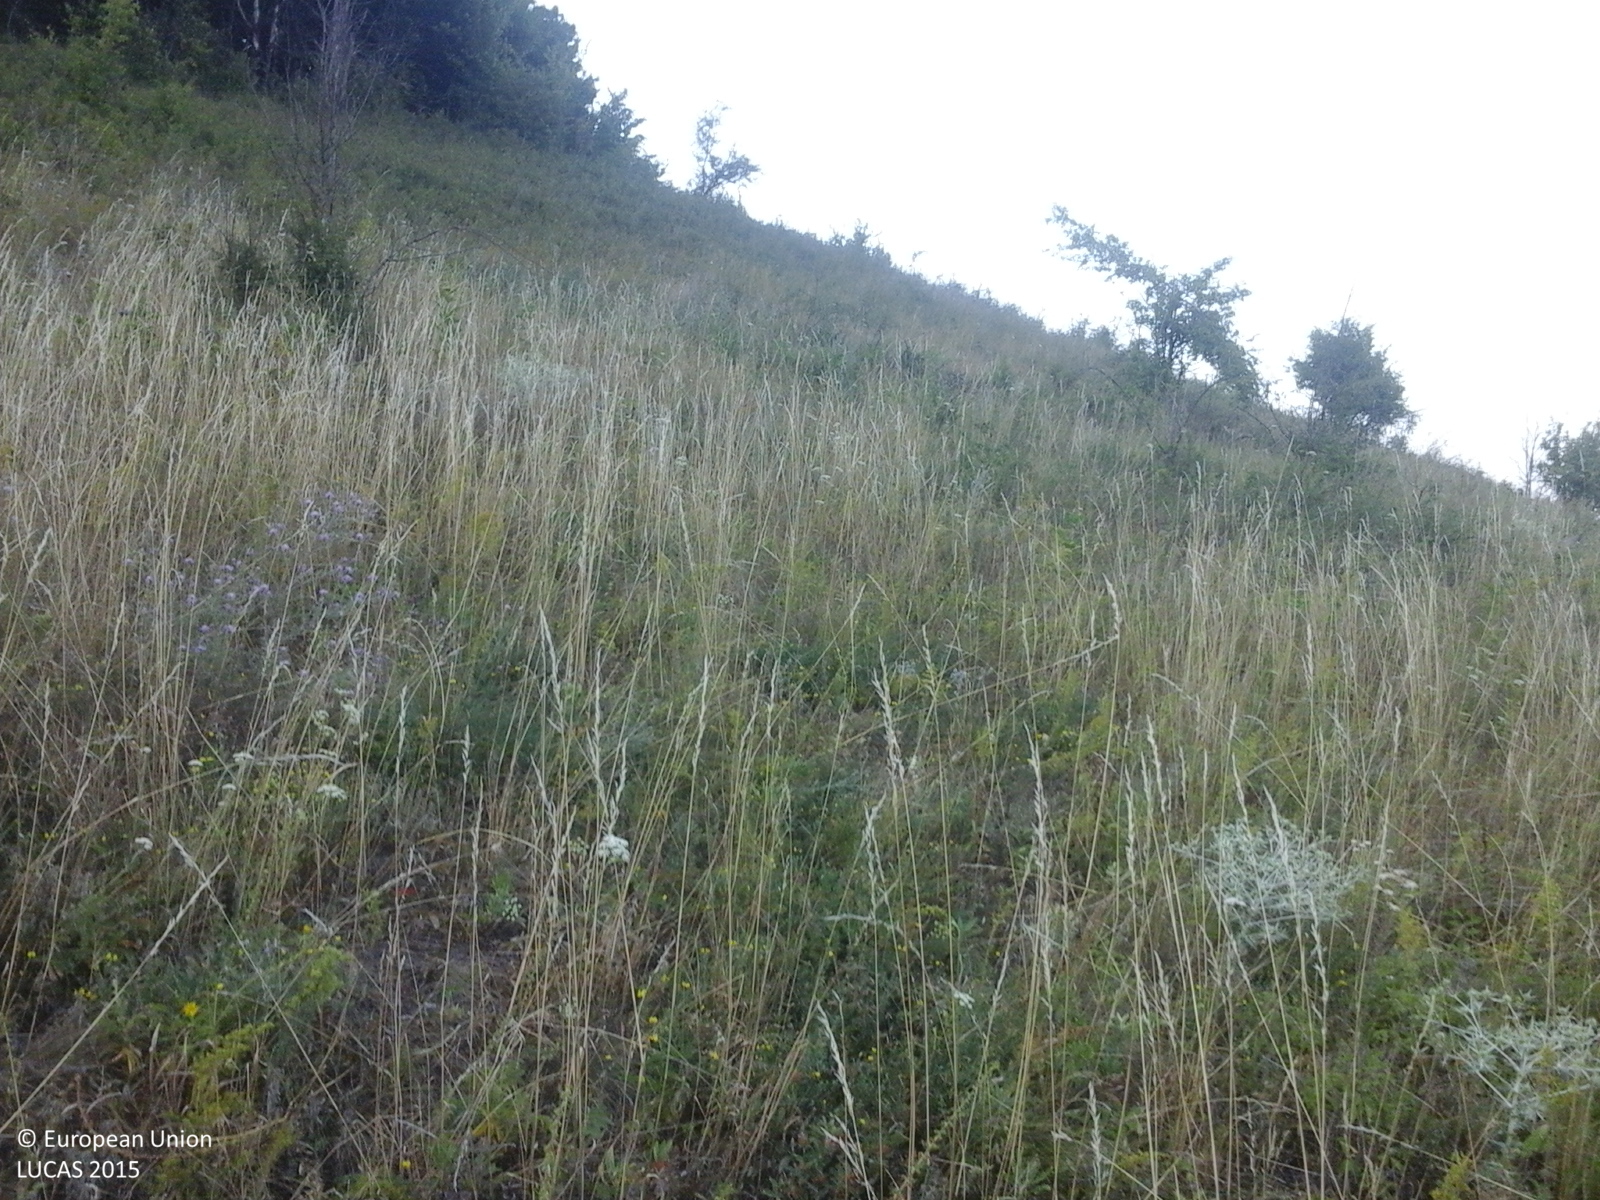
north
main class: Grassland
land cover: Grassland with sparse tree/shrub cover
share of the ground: > 75 %
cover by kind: herbaceous plants 85 %, shrubs 10 %, broadleaved forest trees 5 %
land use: Agriculture (excluding fallow land and kitchen gardens)
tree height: > 5 m
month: July
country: RO
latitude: 46.4971
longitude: 27.1561
